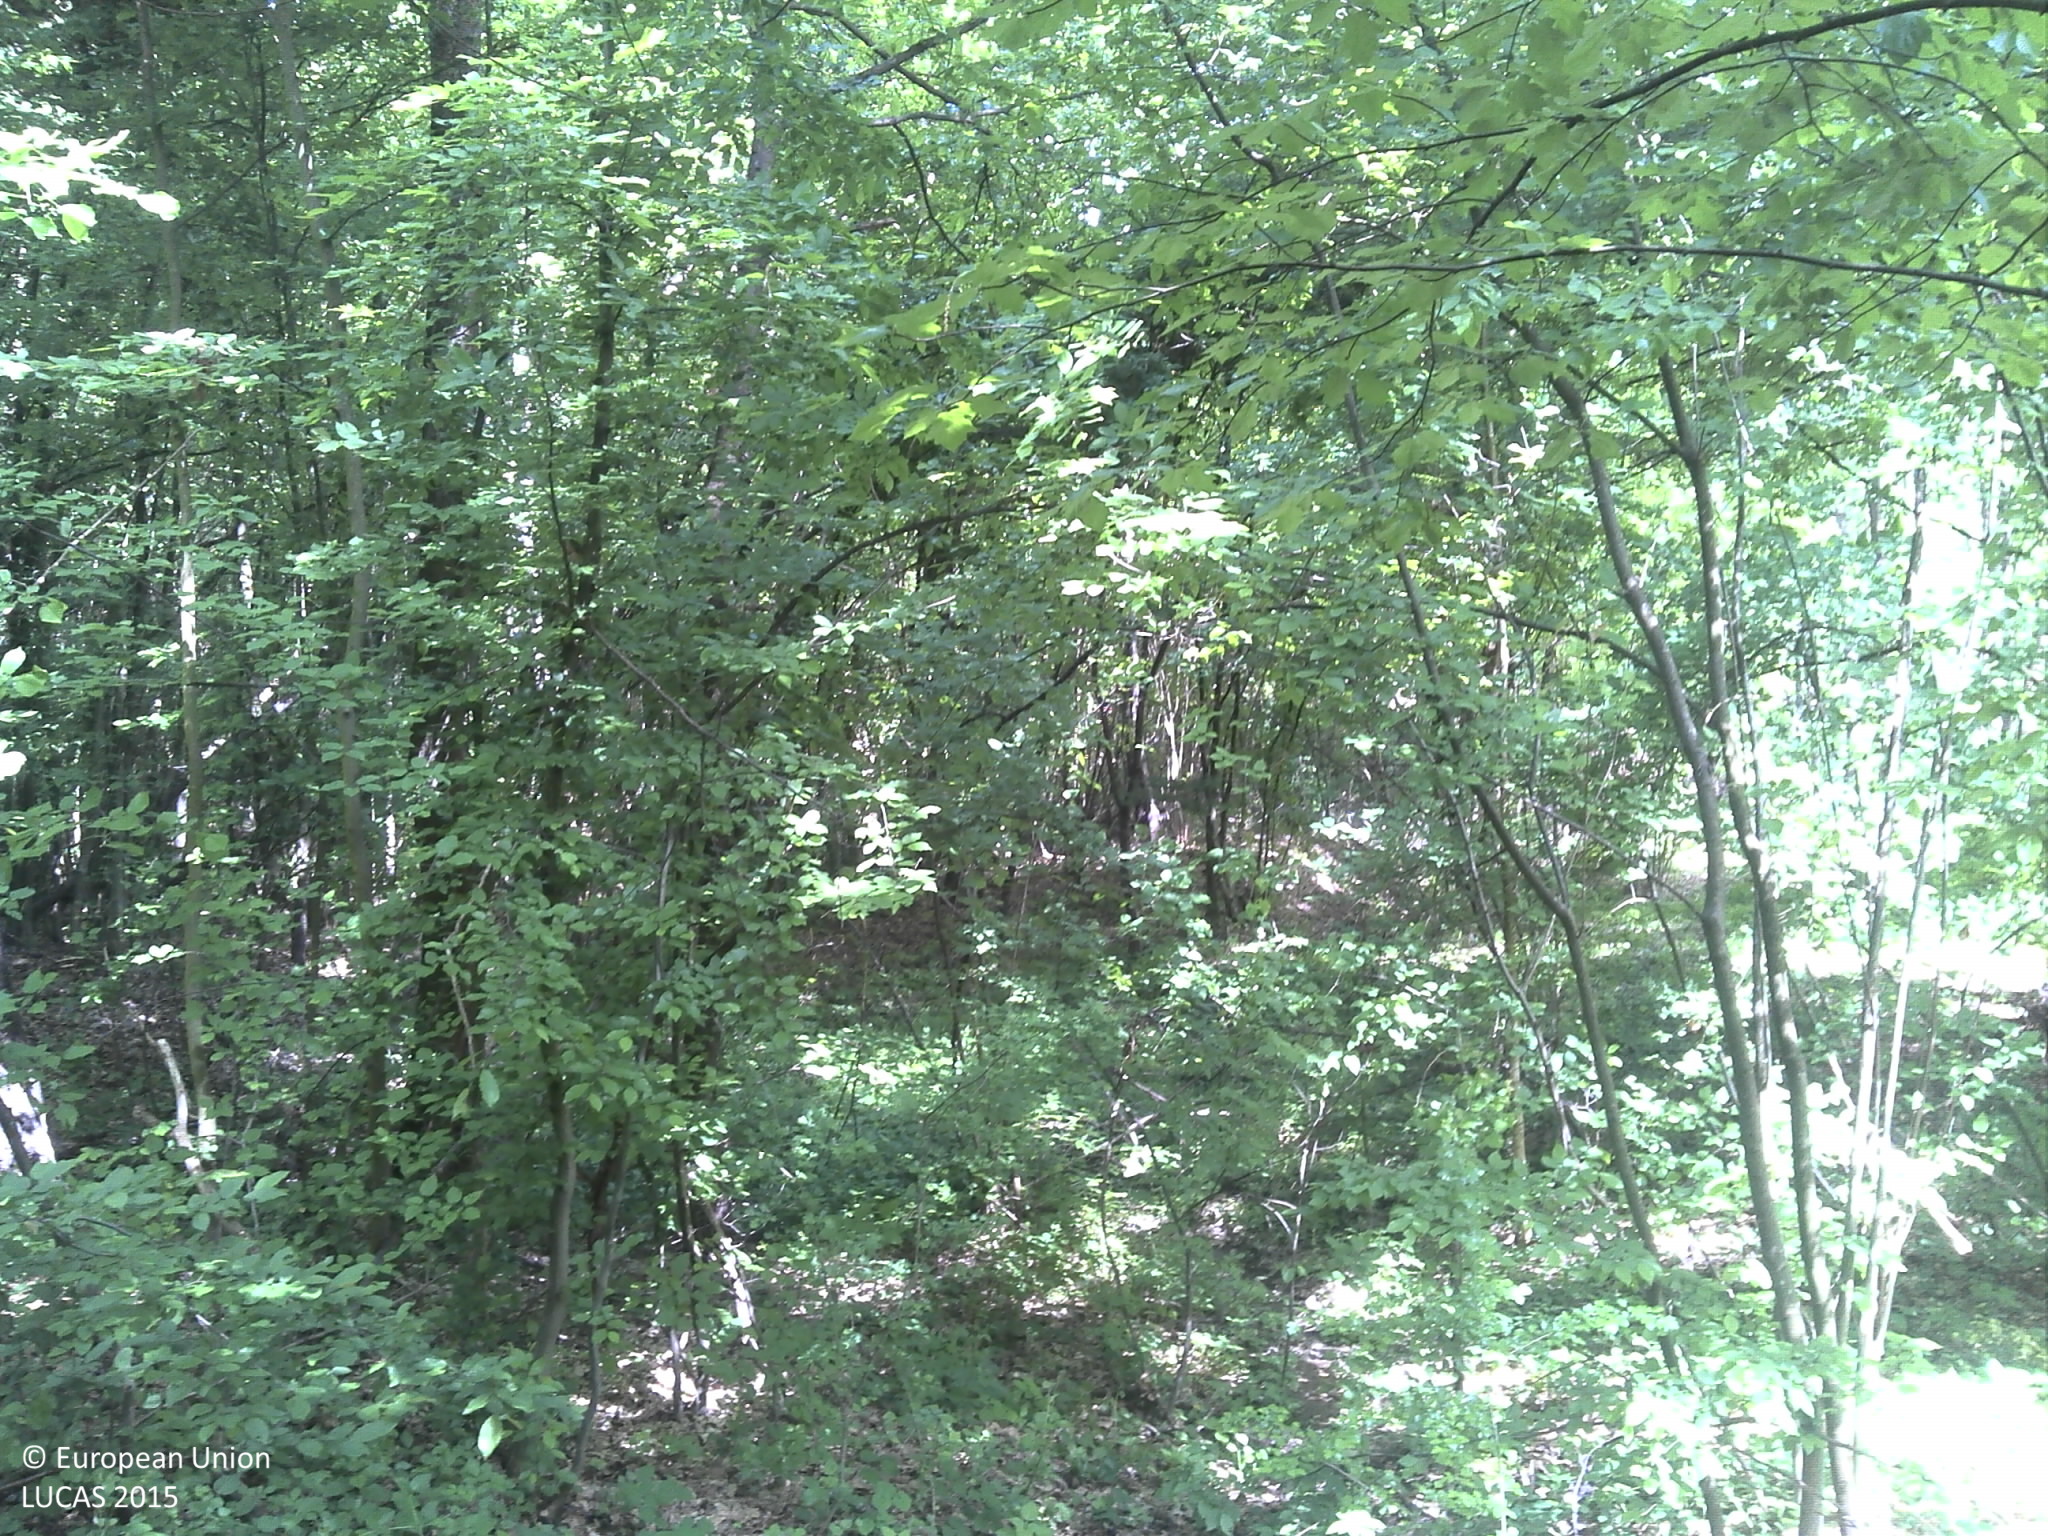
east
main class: Woodland
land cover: Broadleaved woodland
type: acidophilous oak and oak-birch forest
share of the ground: > 75 %
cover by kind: broadleaved forest trees 100 %
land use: Forestry
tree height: > 5 m
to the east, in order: Broadleaved woodland; Ponds and wetlands; Broadleaved woodland; Shrubland with sparse tree cover; Common wheat; Tracks; Broadleaved woodland
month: May
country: HR
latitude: 45.3690
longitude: 18.1628
